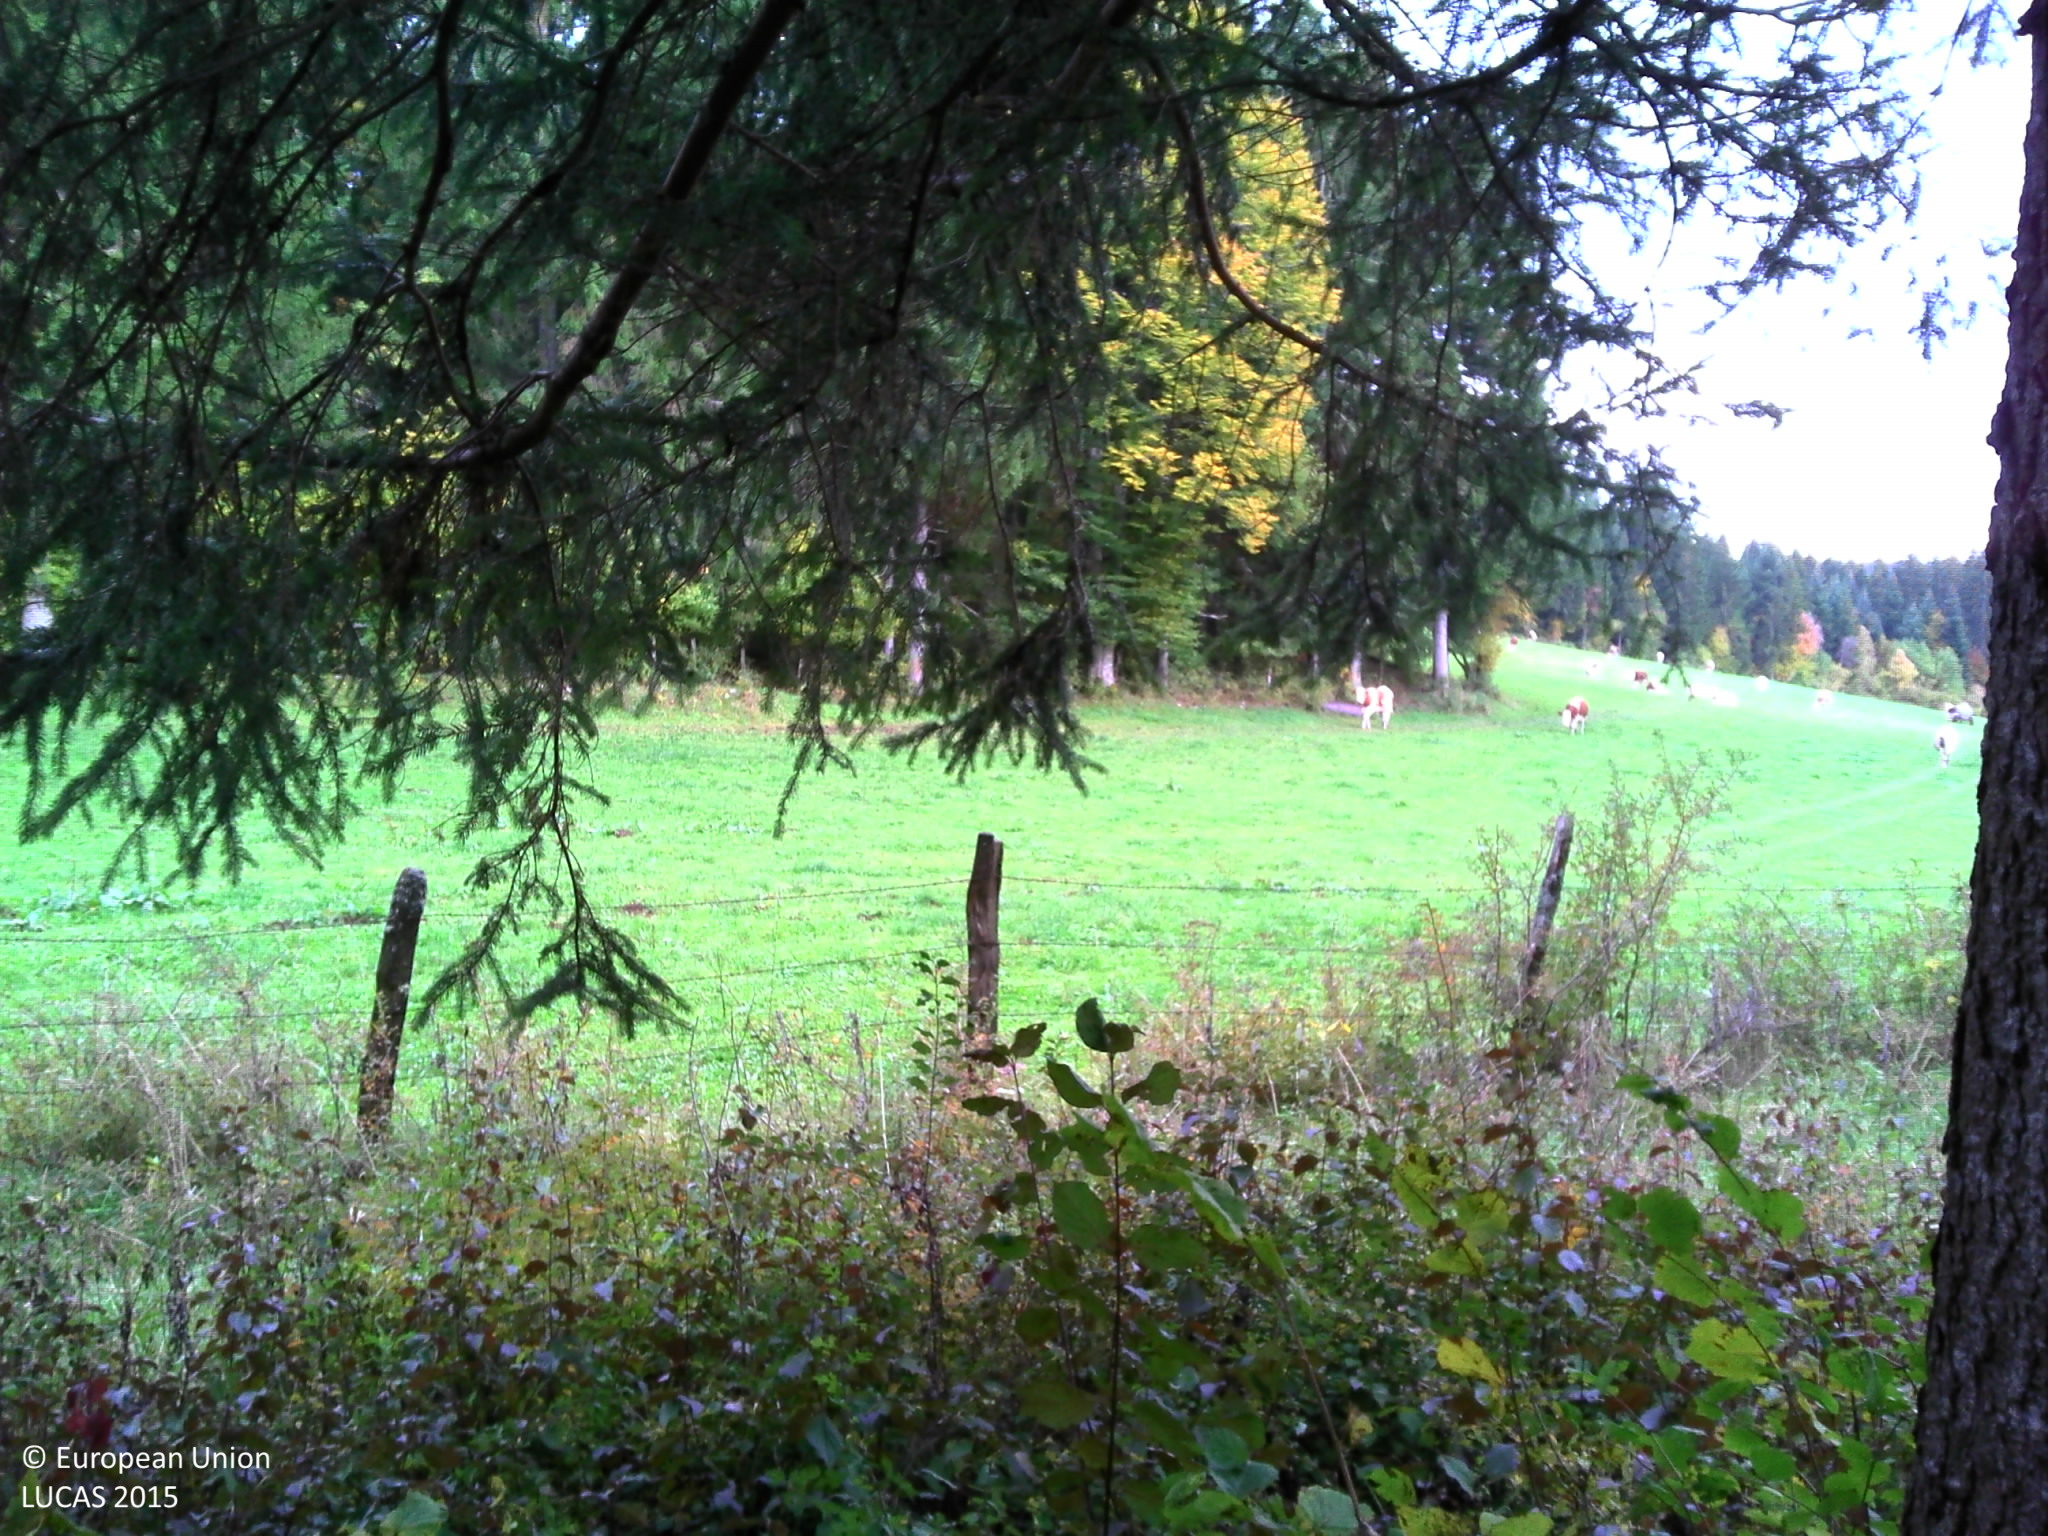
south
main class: Woodland
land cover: Spruce dominated coniferous woodland
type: hemiboreal forest and nemoral coniferous forest and mixed broadleaved-coniferous forest
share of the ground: > 75 %
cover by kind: coniferous forest trees 100 %
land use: Forestry
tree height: > 5 m
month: October
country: FR
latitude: 46.7739
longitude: 6.2964
